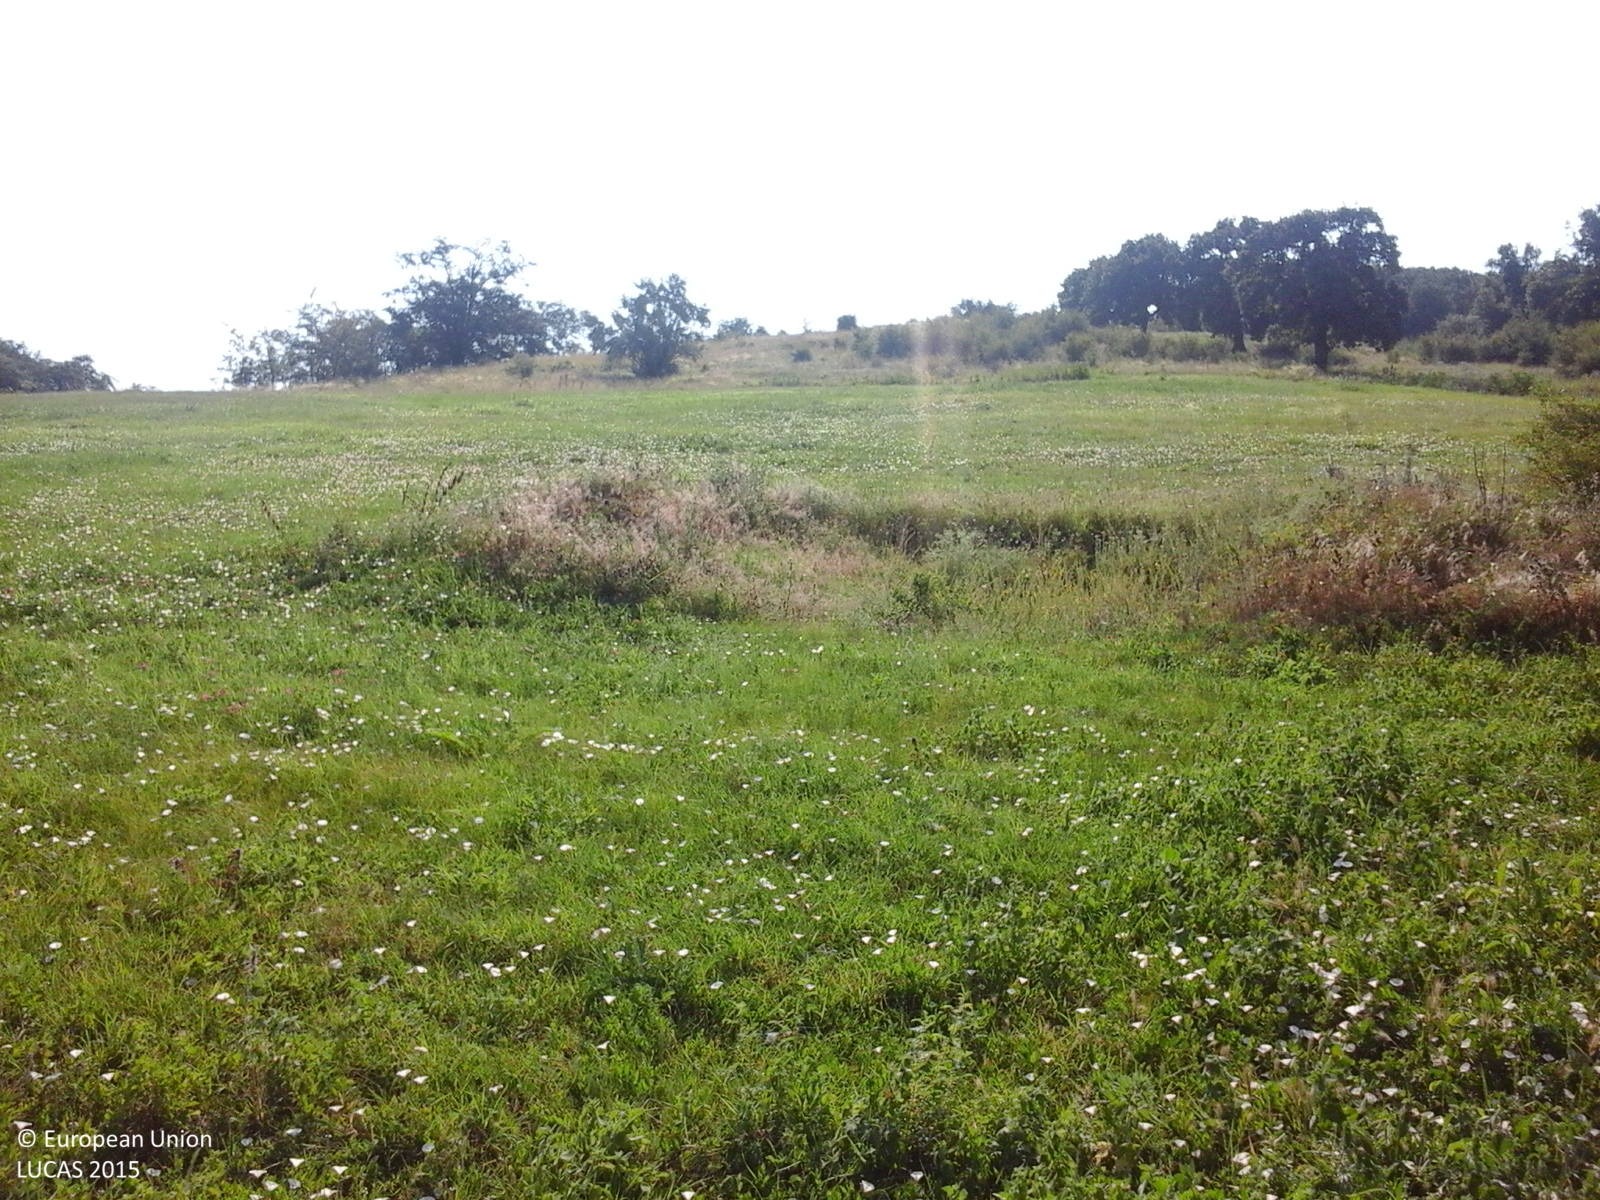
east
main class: Grassland
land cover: Grassland without tree/shrub cover
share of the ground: > 75 %
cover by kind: herbaceous plants 100 %
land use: Agriculture (excluding fallow land and kitchen gardens)
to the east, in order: Grassland without tree/shrub cover; Tracks; Broadleaved woodland; Grassland without tree/shrub cover
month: July
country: RO
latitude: 45.9788
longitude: 28.0522
